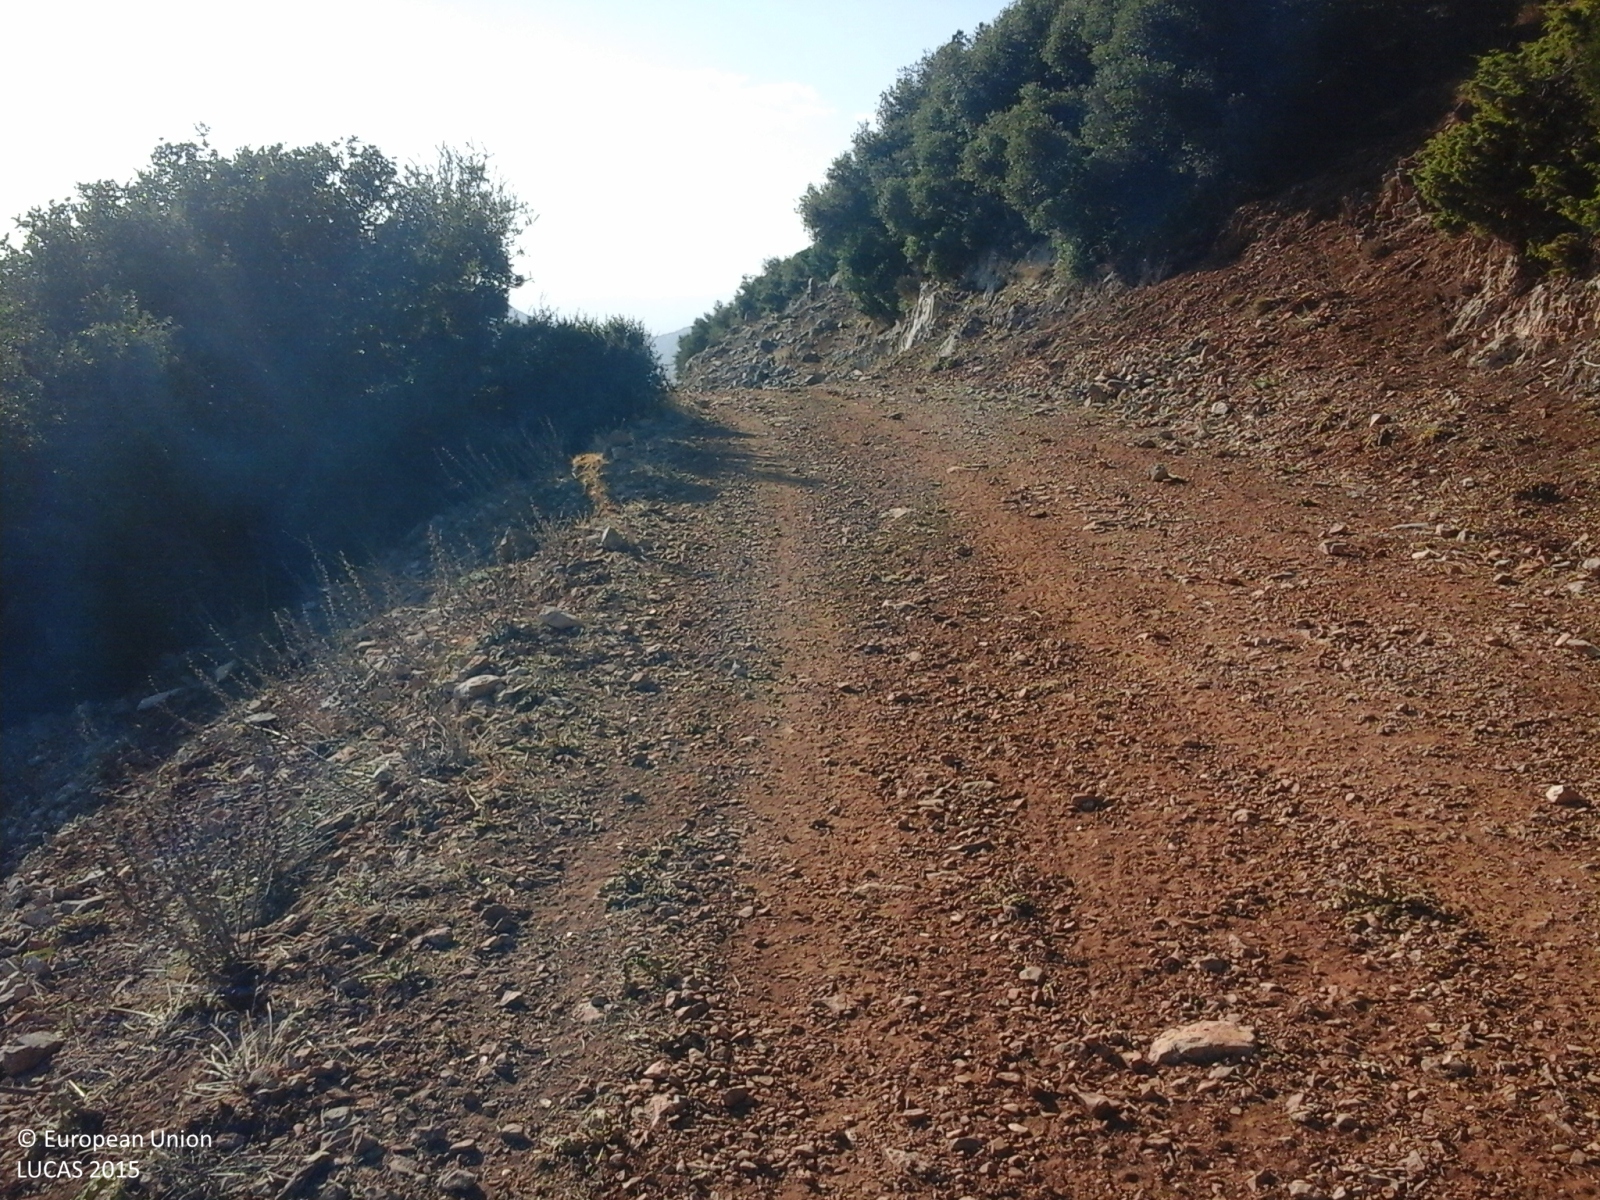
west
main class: Shrubland
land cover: Shrubland without tree cover
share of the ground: > 75 %
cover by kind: shrubs 85 %, unconsolidated bare surface 10 %, herbaceous plants 5 %
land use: Agriculture (excluding fallow land and kitchen gardens)
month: September
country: GR
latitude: 38.4723
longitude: 22.2496
